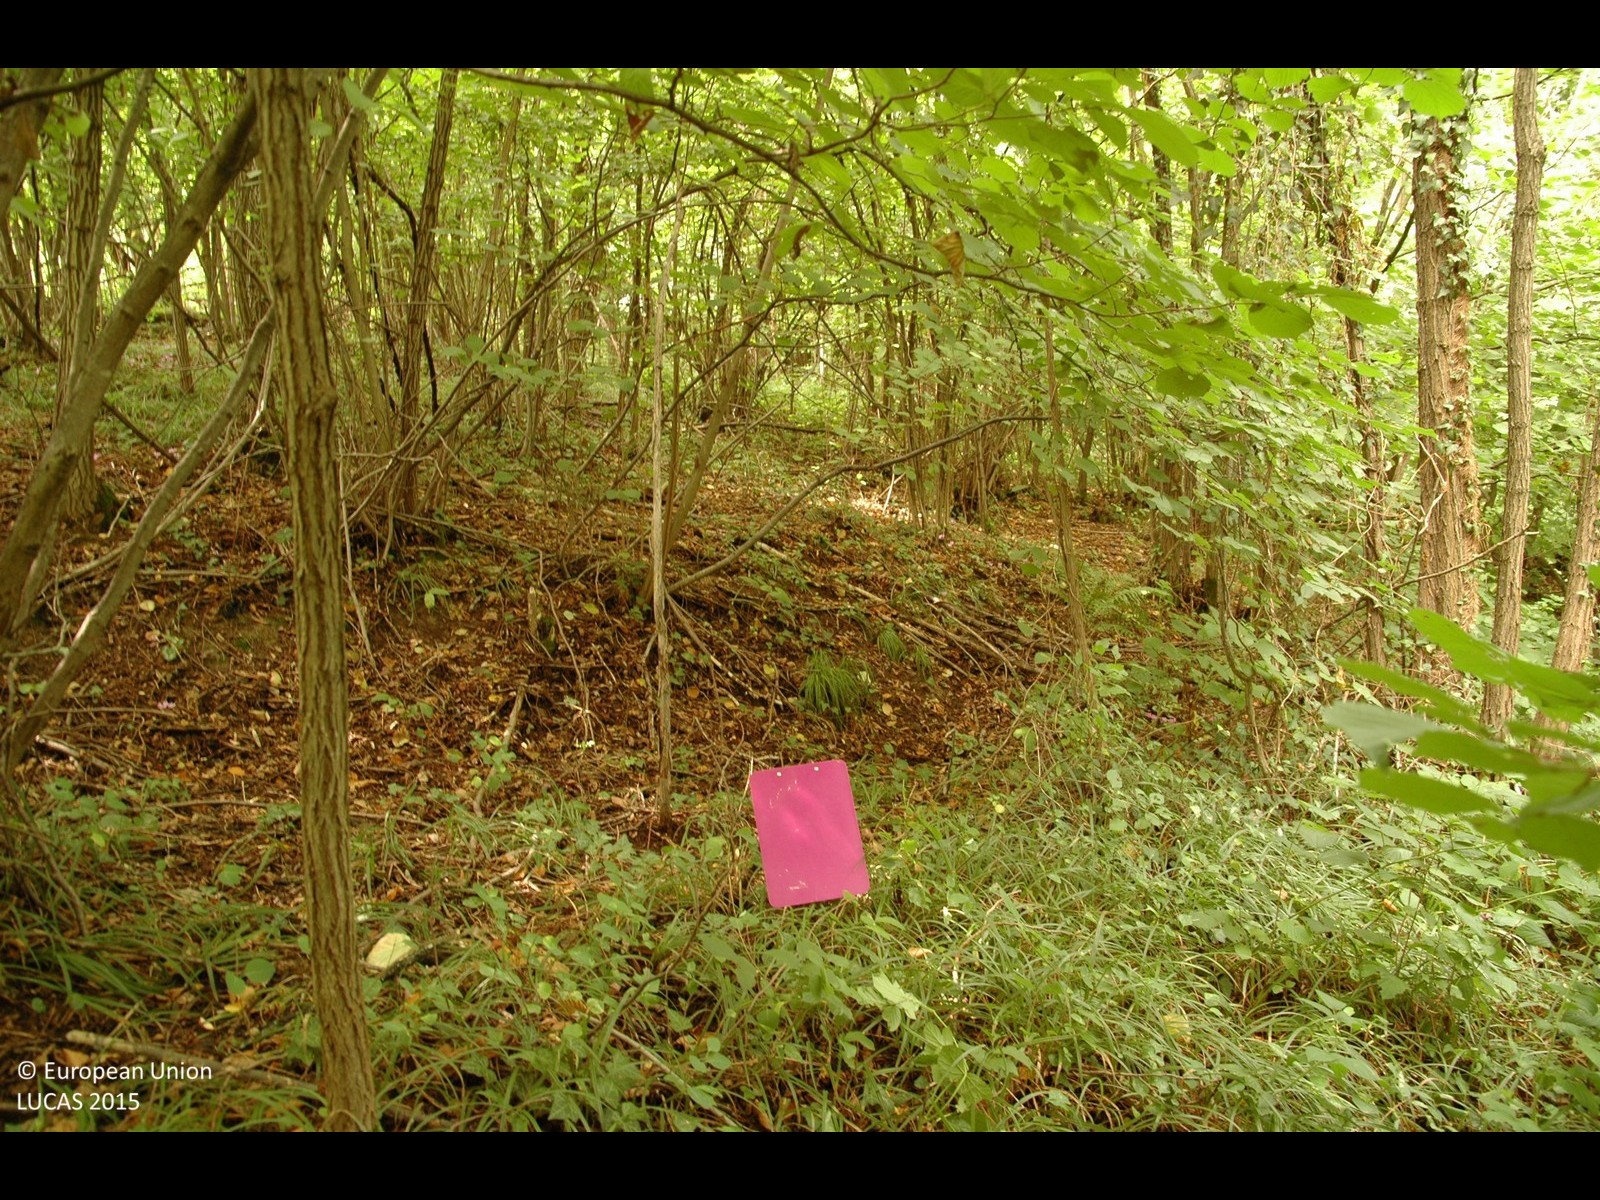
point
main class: Woodland
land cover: Broadleaved woodland
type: mesophytic deciduous forest
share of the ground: > 75 %
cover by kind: broadleaved forest trees 100 %
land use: Forestry
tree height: > 5 m
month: August
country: HR
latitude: 45.9034
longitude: 16.1471
